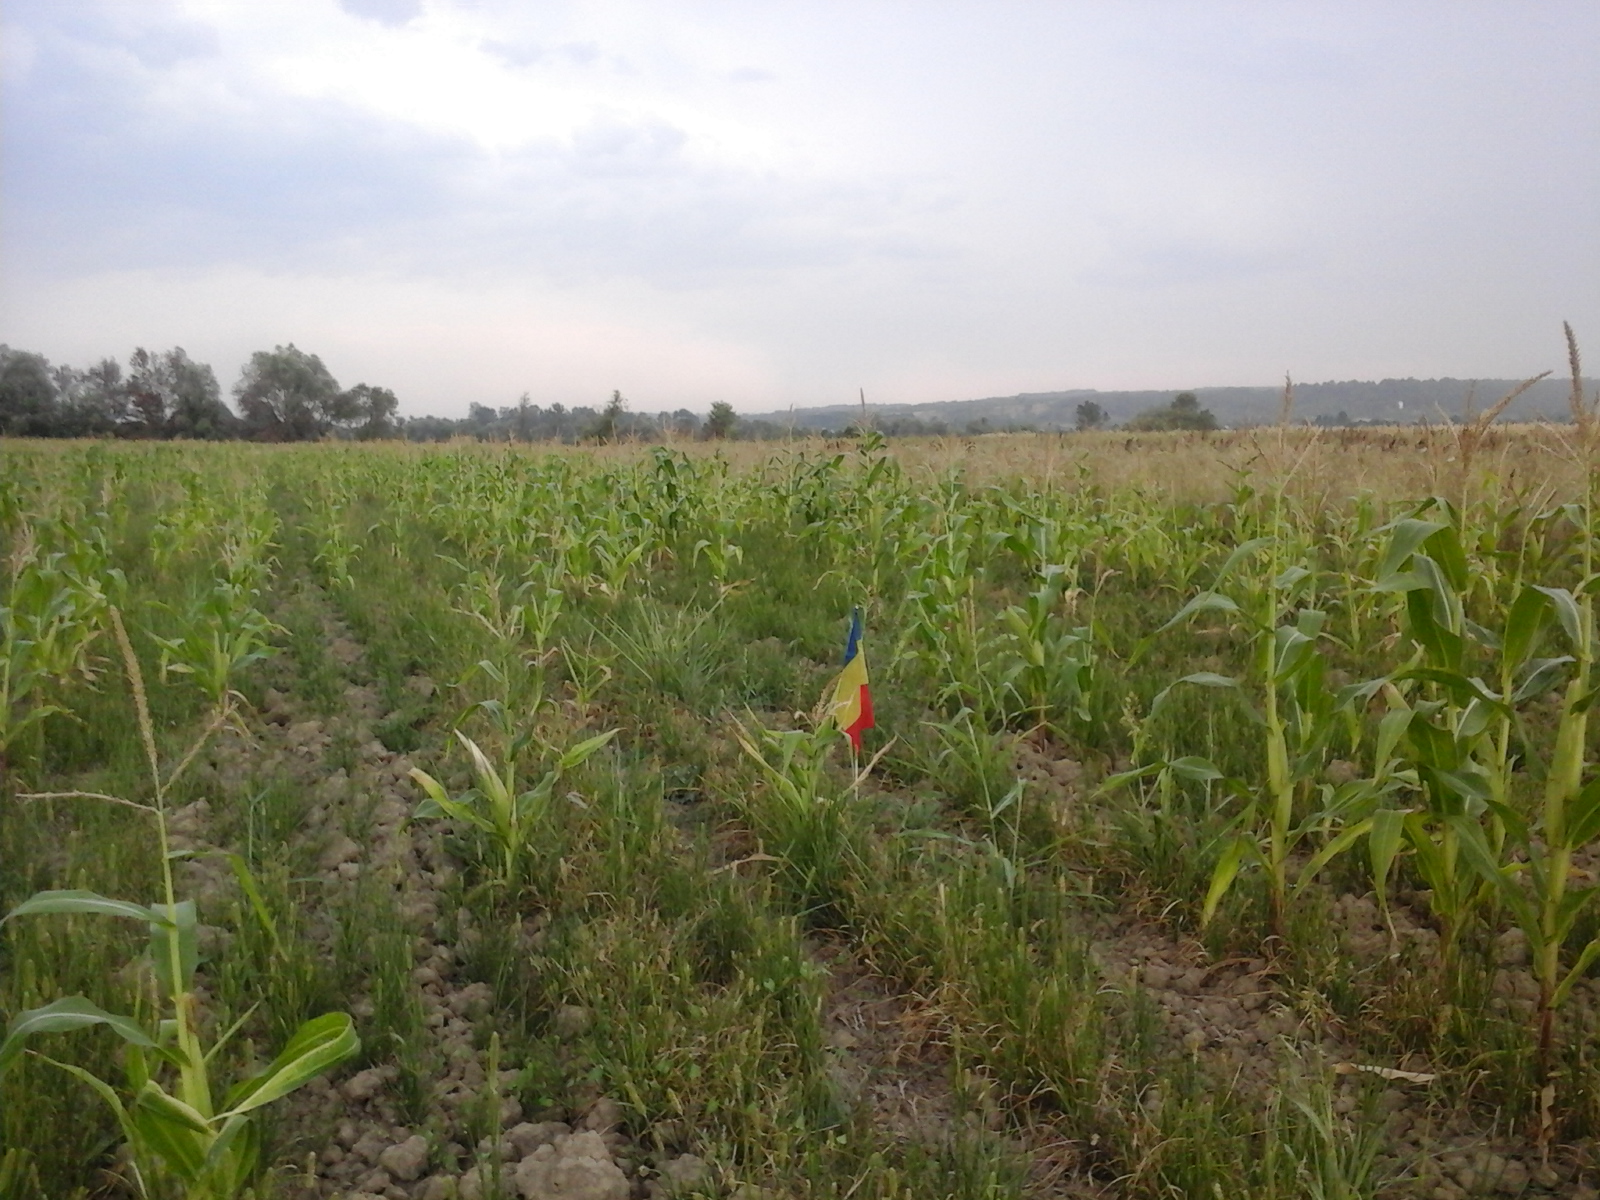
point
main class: Cropland
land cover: Maize
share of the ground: 25 - 50 %
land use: Agriculture (excluding fallow land and kitchen gardens)
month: August
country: RO
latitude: 44.6418
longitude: 23.4300
